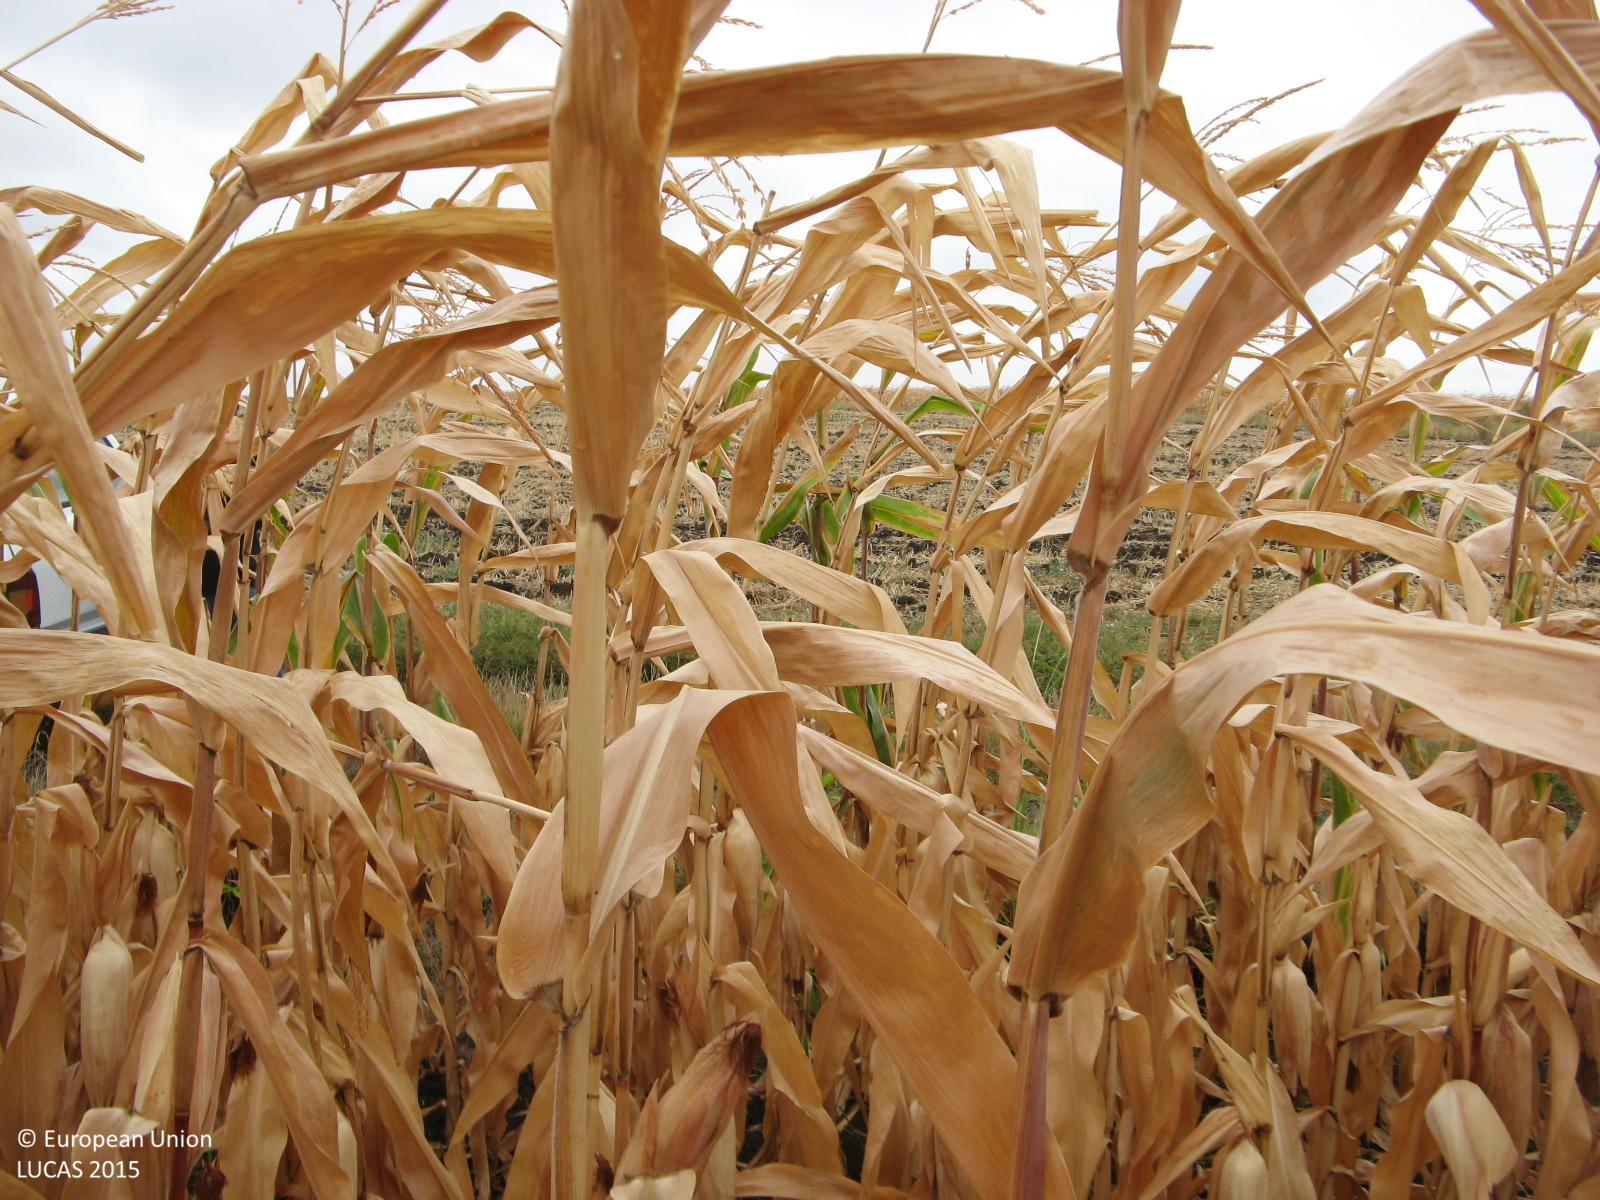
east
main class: Cropland
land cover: Maize
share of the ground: > 75 %
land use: Agriculture (excluding fallow land and kitchen gardens)
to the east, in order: Maize; Grass margins; Tracks; Grass margins; Common wheat
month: August
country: BG
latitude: 43.3769
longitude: 25.3949
